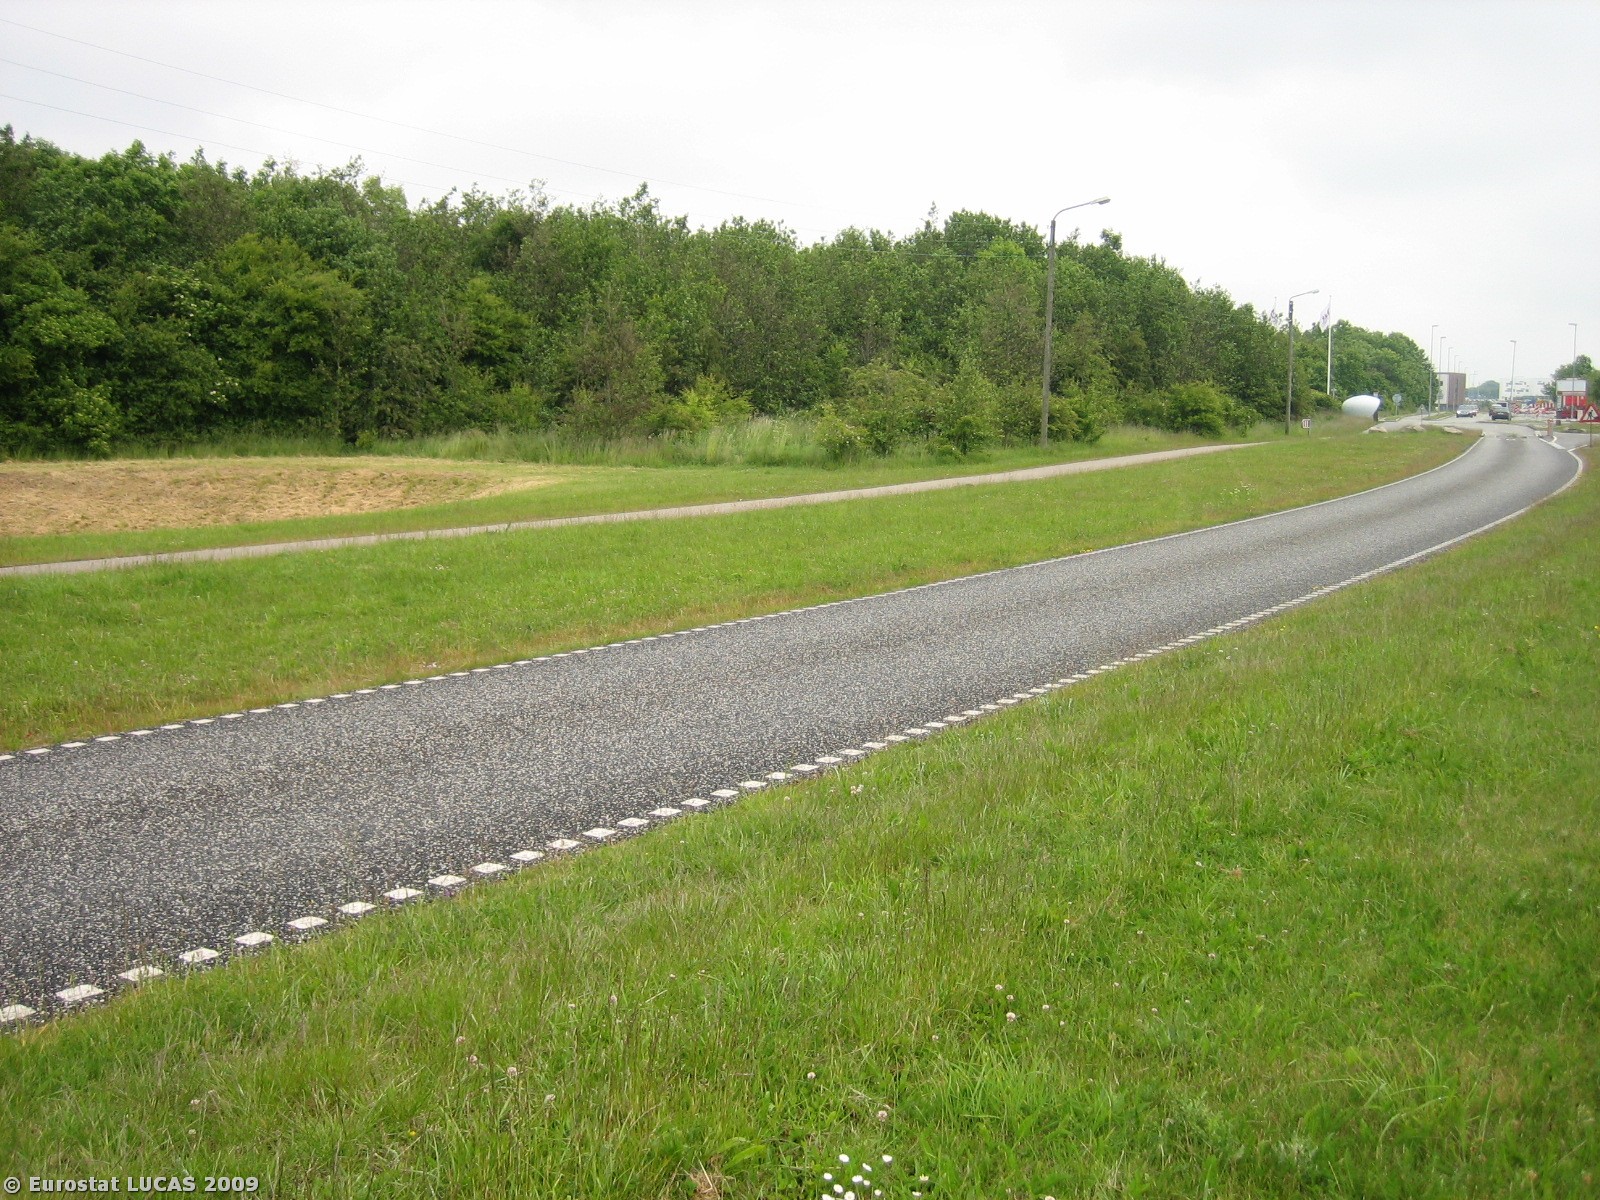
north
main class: Grassland
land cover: Grassland without tree/shrub cover
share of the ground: > 75 %
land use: Unused
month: June
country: DK
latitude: 56.1876
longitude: 10.1770
